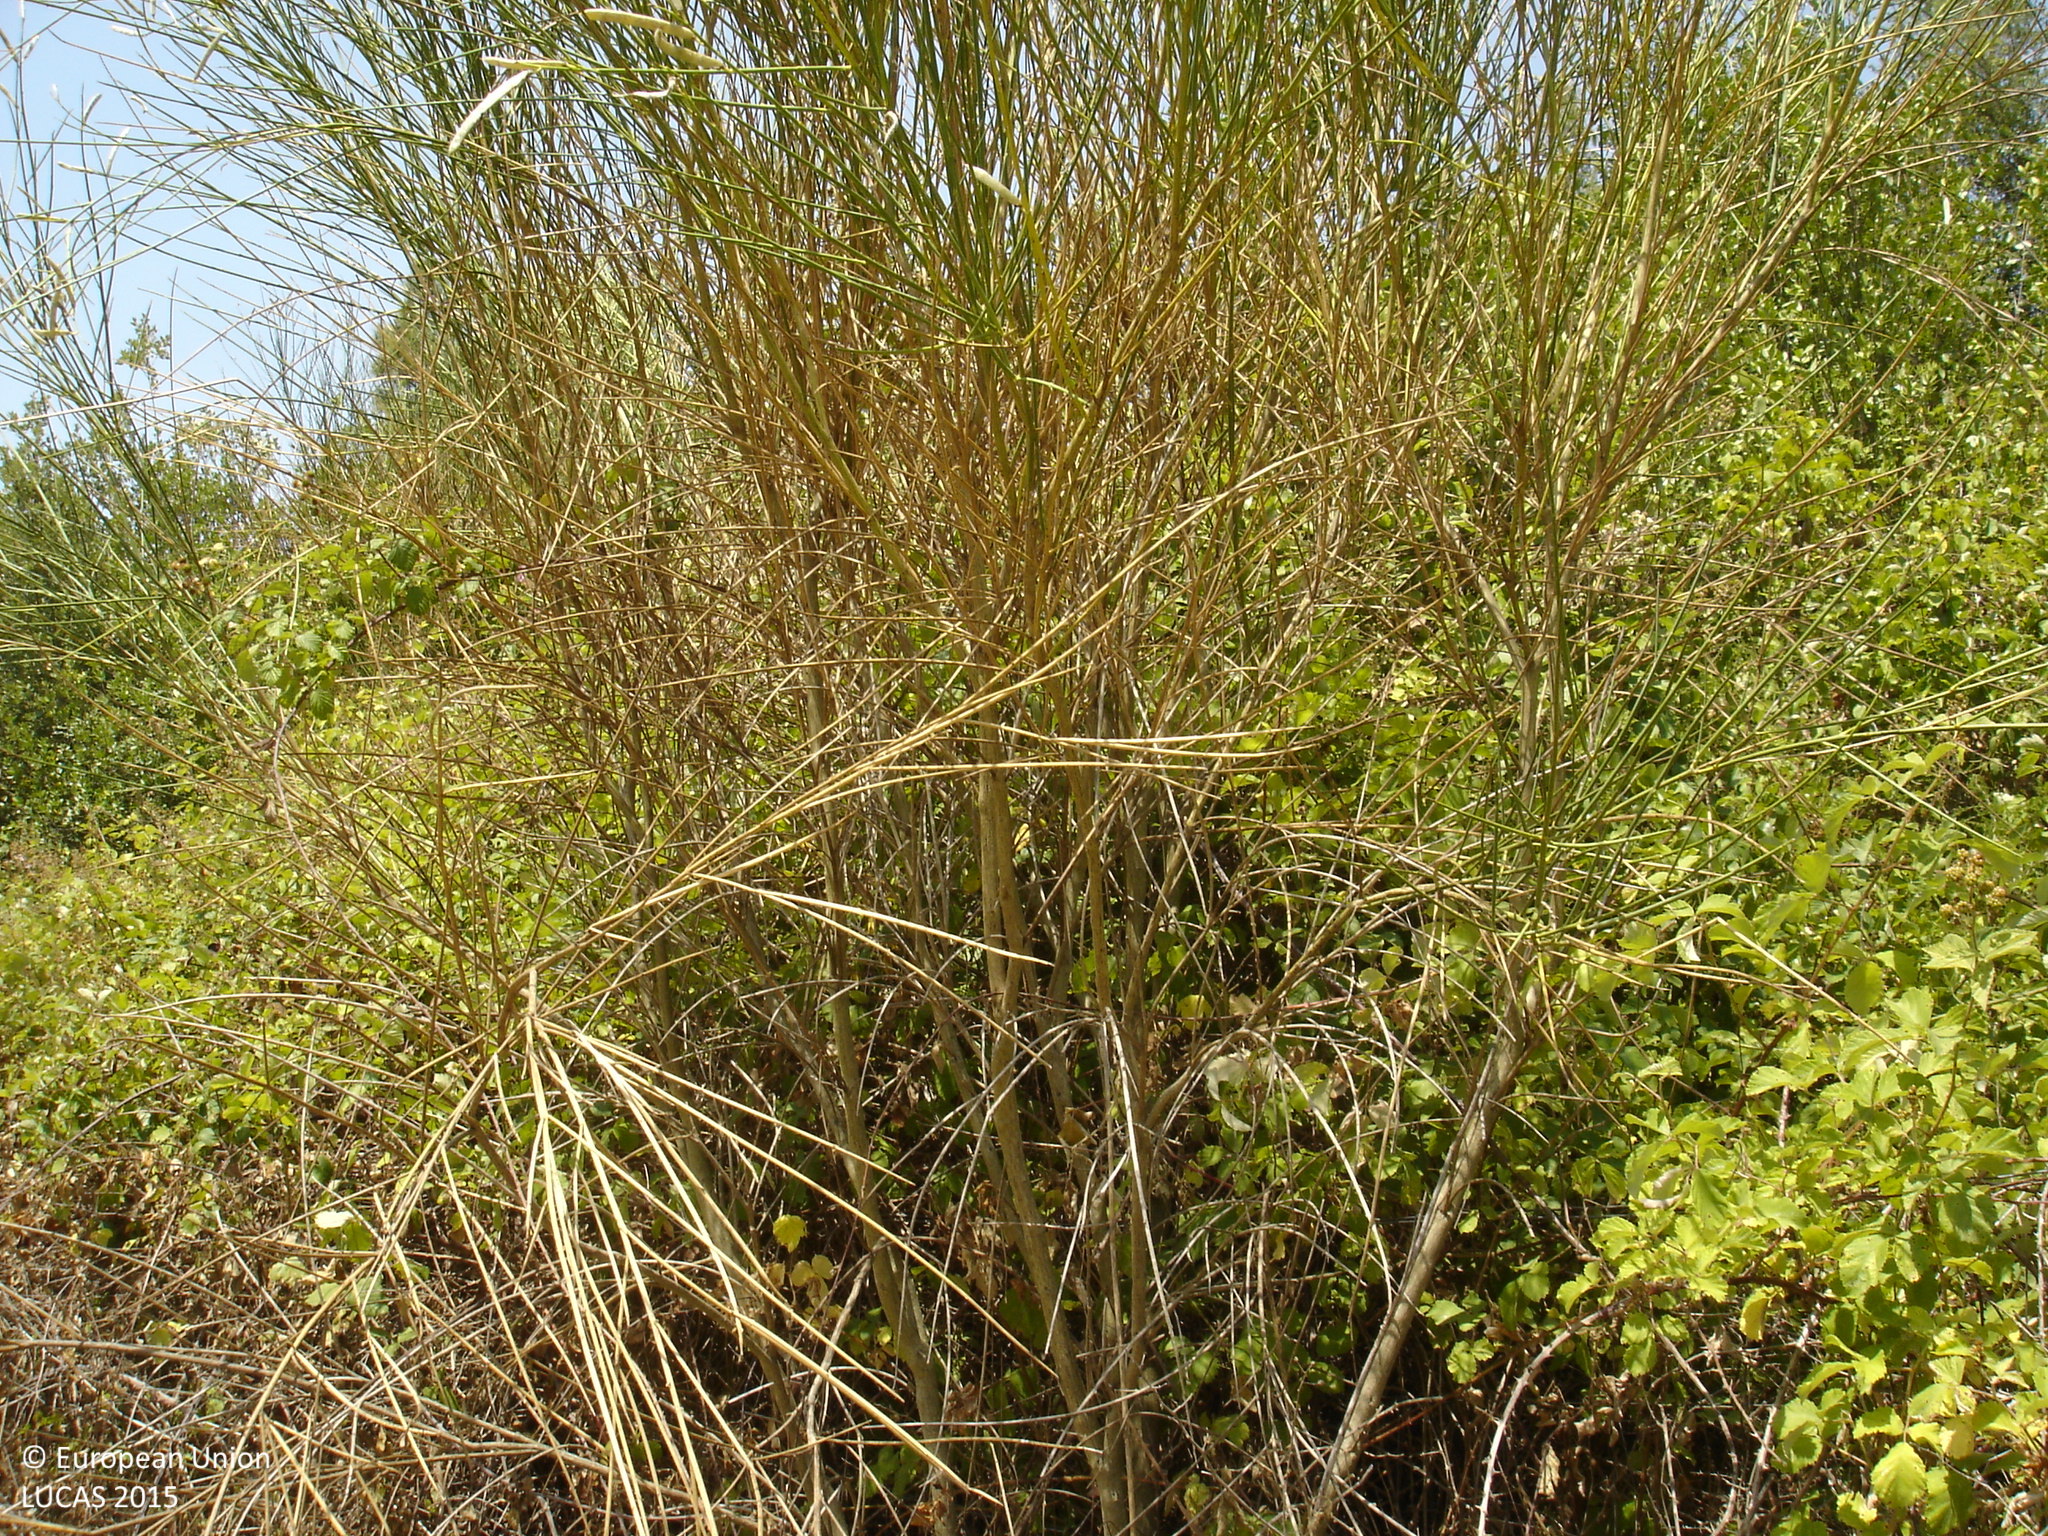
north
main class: Shrubland
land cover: Shrubland with sparse tree cover
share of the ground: > 75 %
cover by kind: shrubs 90 %, coniferous forest trees 5 %, herbaceous plants 5 %
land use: Semi-natural and natural areas not in use
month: July
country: ES
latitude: 41.9247
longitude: 3.0342
